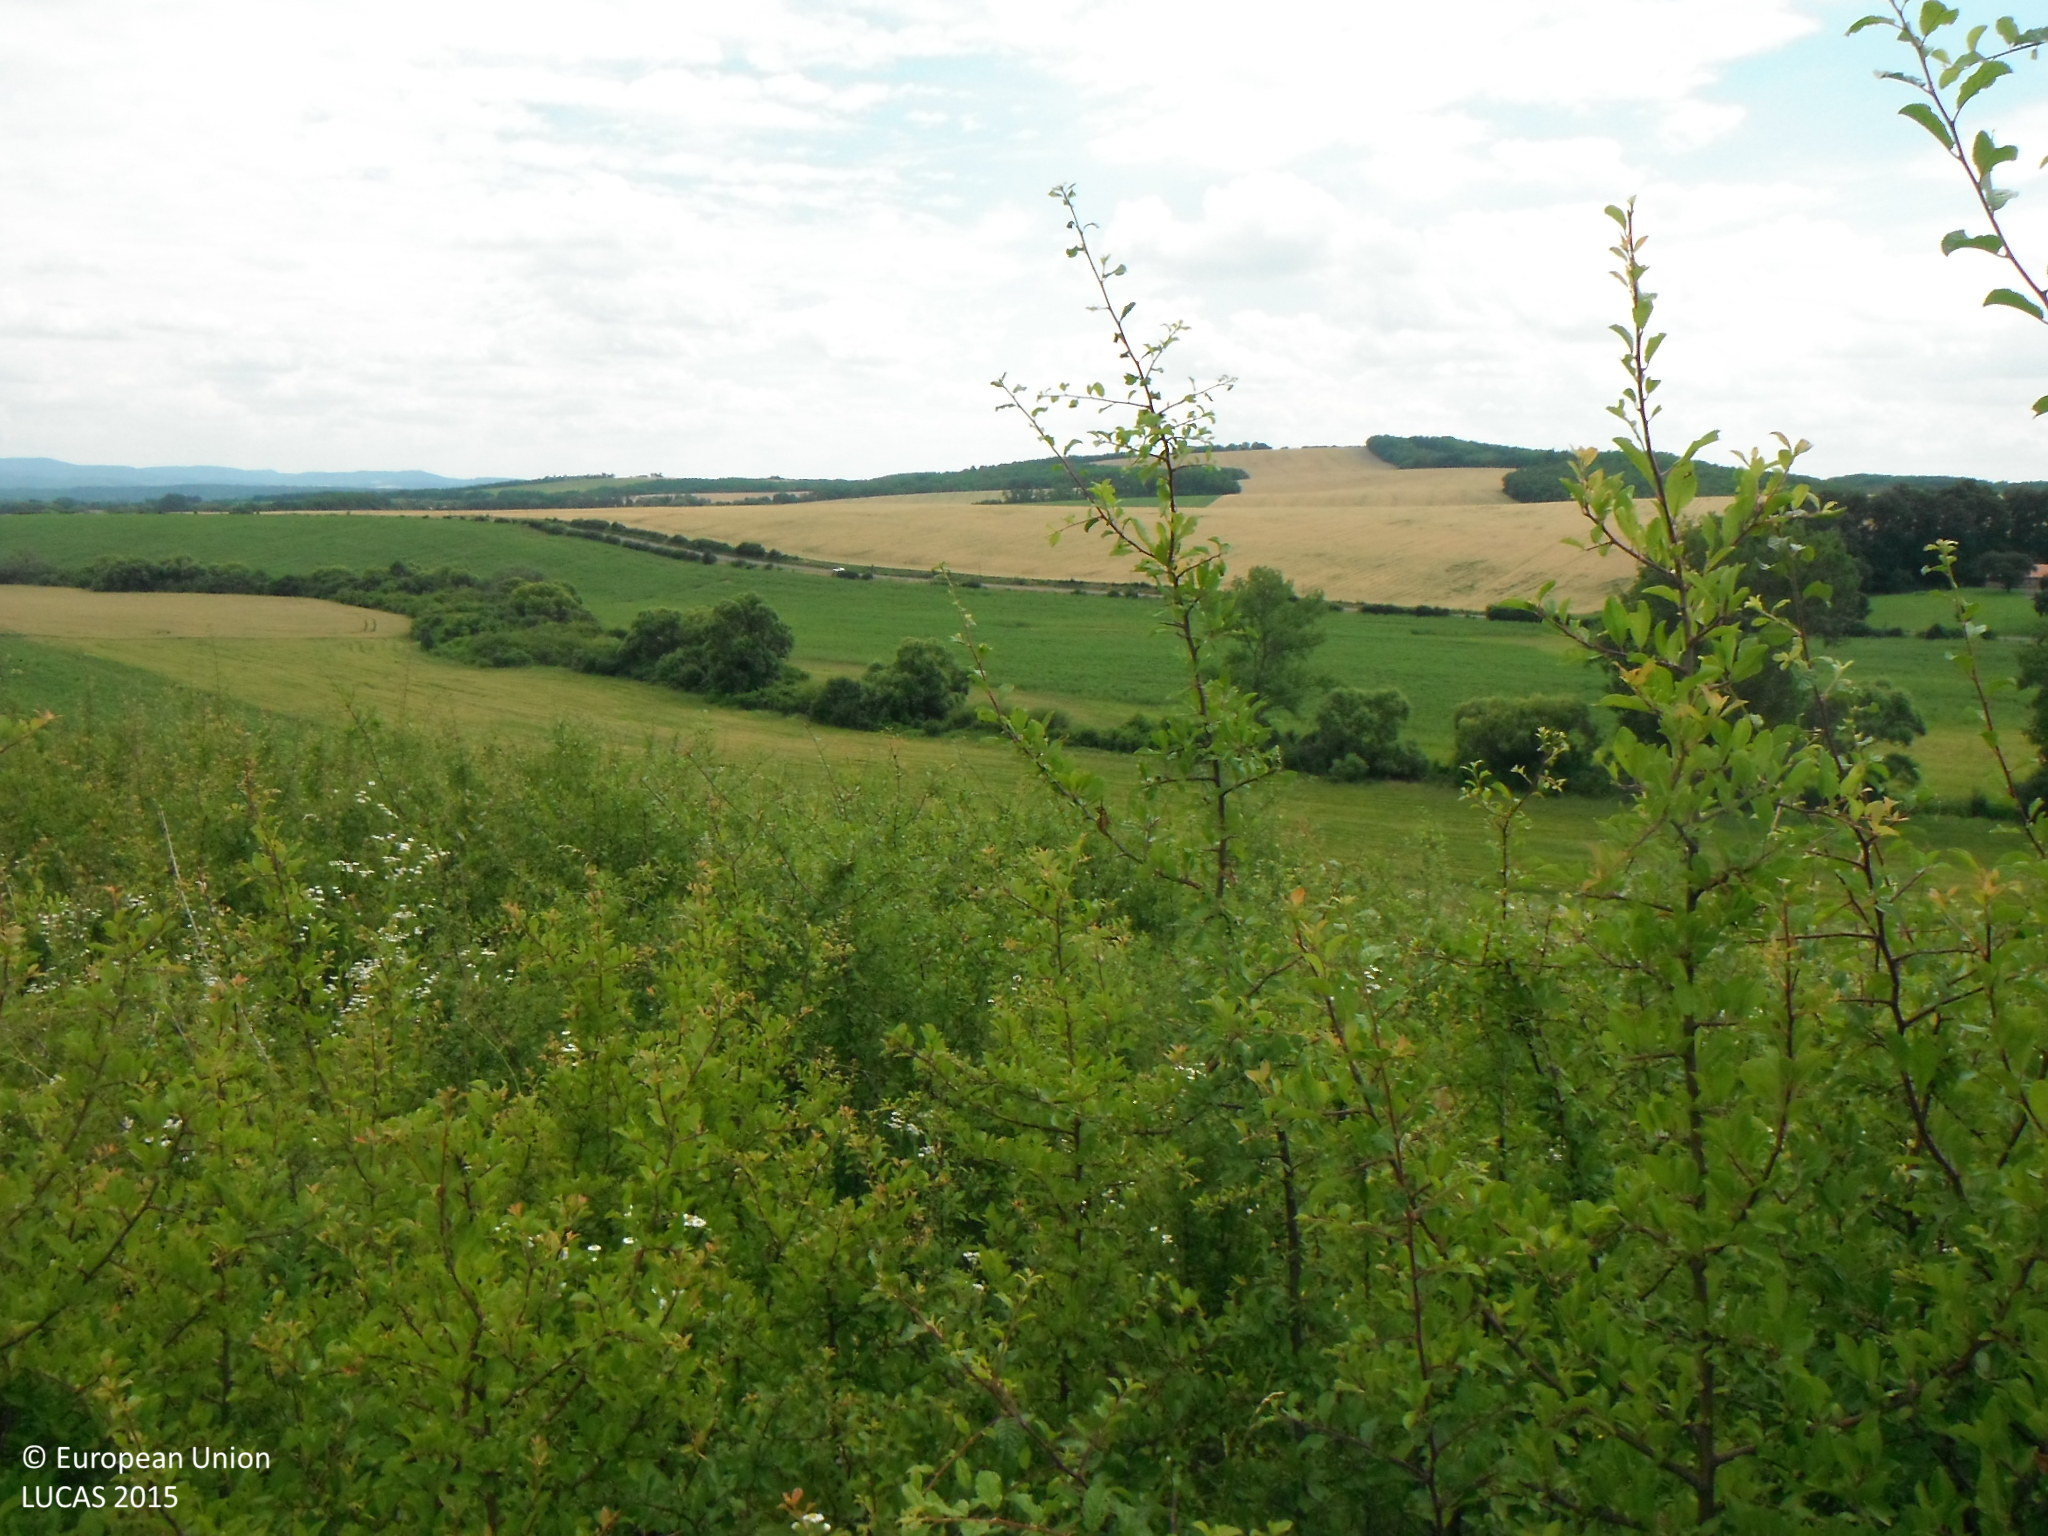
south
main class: Shrubland
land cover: Shrubland without tree cover
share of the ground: > 75 %
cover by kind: shrubs 90 %, herbaceous plants 10 %
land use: Semi-natural and natural areas not in use
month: June
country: SK
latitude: 48.1410
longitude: 19.4713
